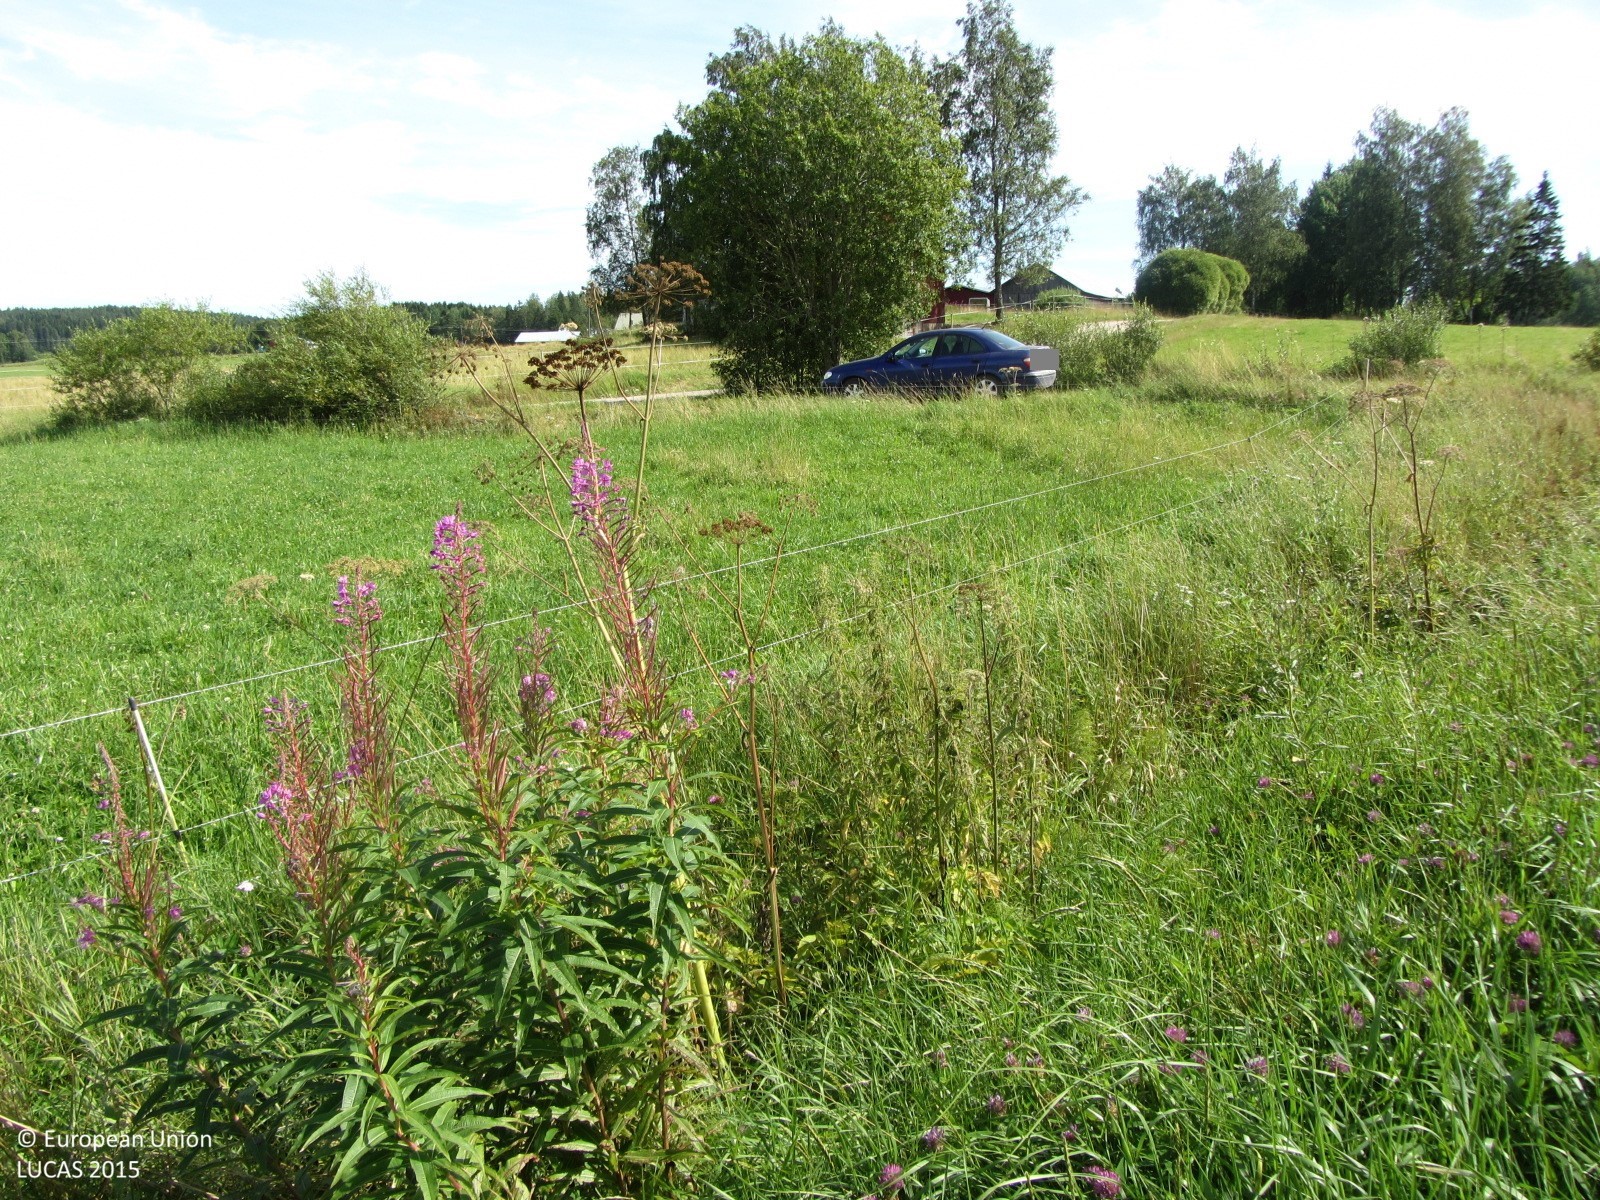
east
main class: Cropland
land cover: Barley
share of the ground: > 75 %
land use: Agriculture (excluding fallow land and kitchen gardens)
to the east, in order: Barley; Grass margins; Ditches and canals; Grass margins; Fences; Grassland without tree/shrub cover; Fences; Ditches and canals; Grassland with sparse tree/shrub cover; Paved roads, cycling and walking lanes; Grass margins; Ditches and canals; Grass margins; Fences; Grassland without tree/shrub cover; Electric lines; Grassland without tree/shrub cover; Electric lines; Grassland without tree/shrub cover; Fences; Grass margins; Fences; Grassland without tree/shrub cover
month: August
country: FI
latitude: 60.4657
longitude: 23.4530
